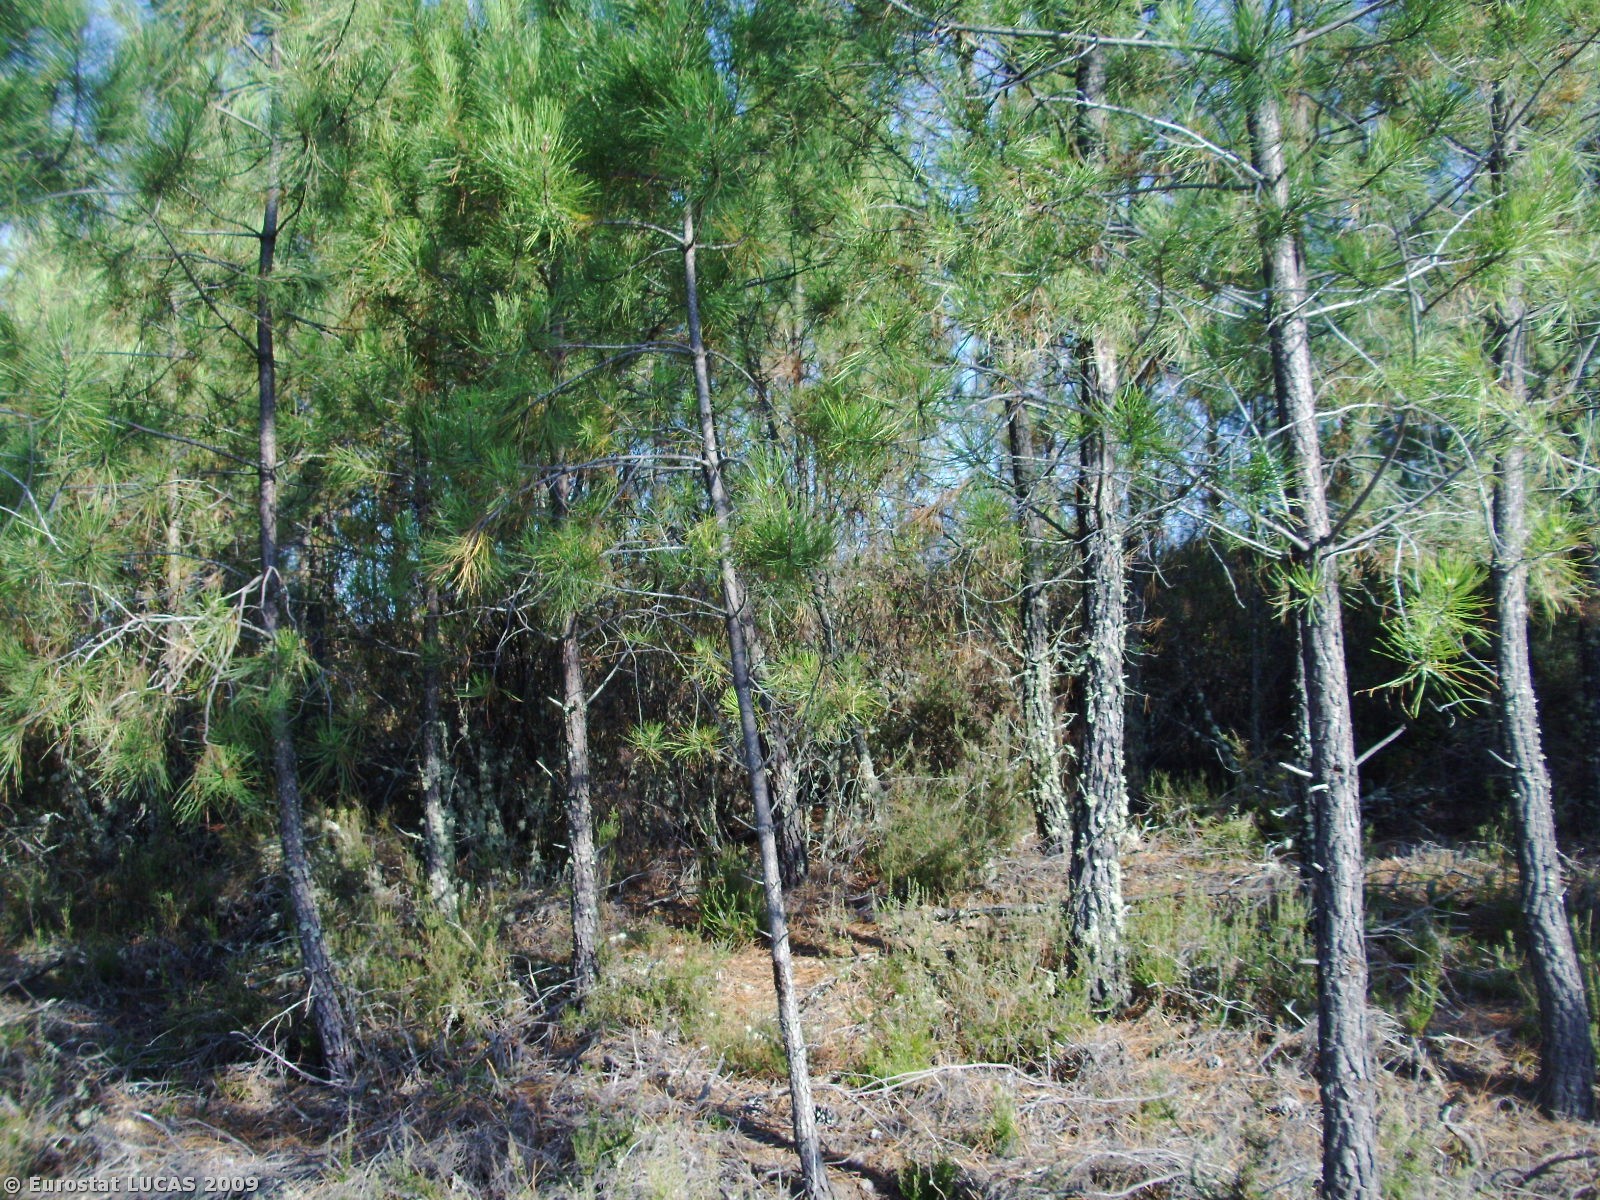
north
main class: Shrubland
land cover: Shrubland with sparse tree cover
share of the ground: > 75 %
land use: Unused
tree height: > 5 m
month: August
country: PT
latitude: 40.1737
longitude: -7.7136
